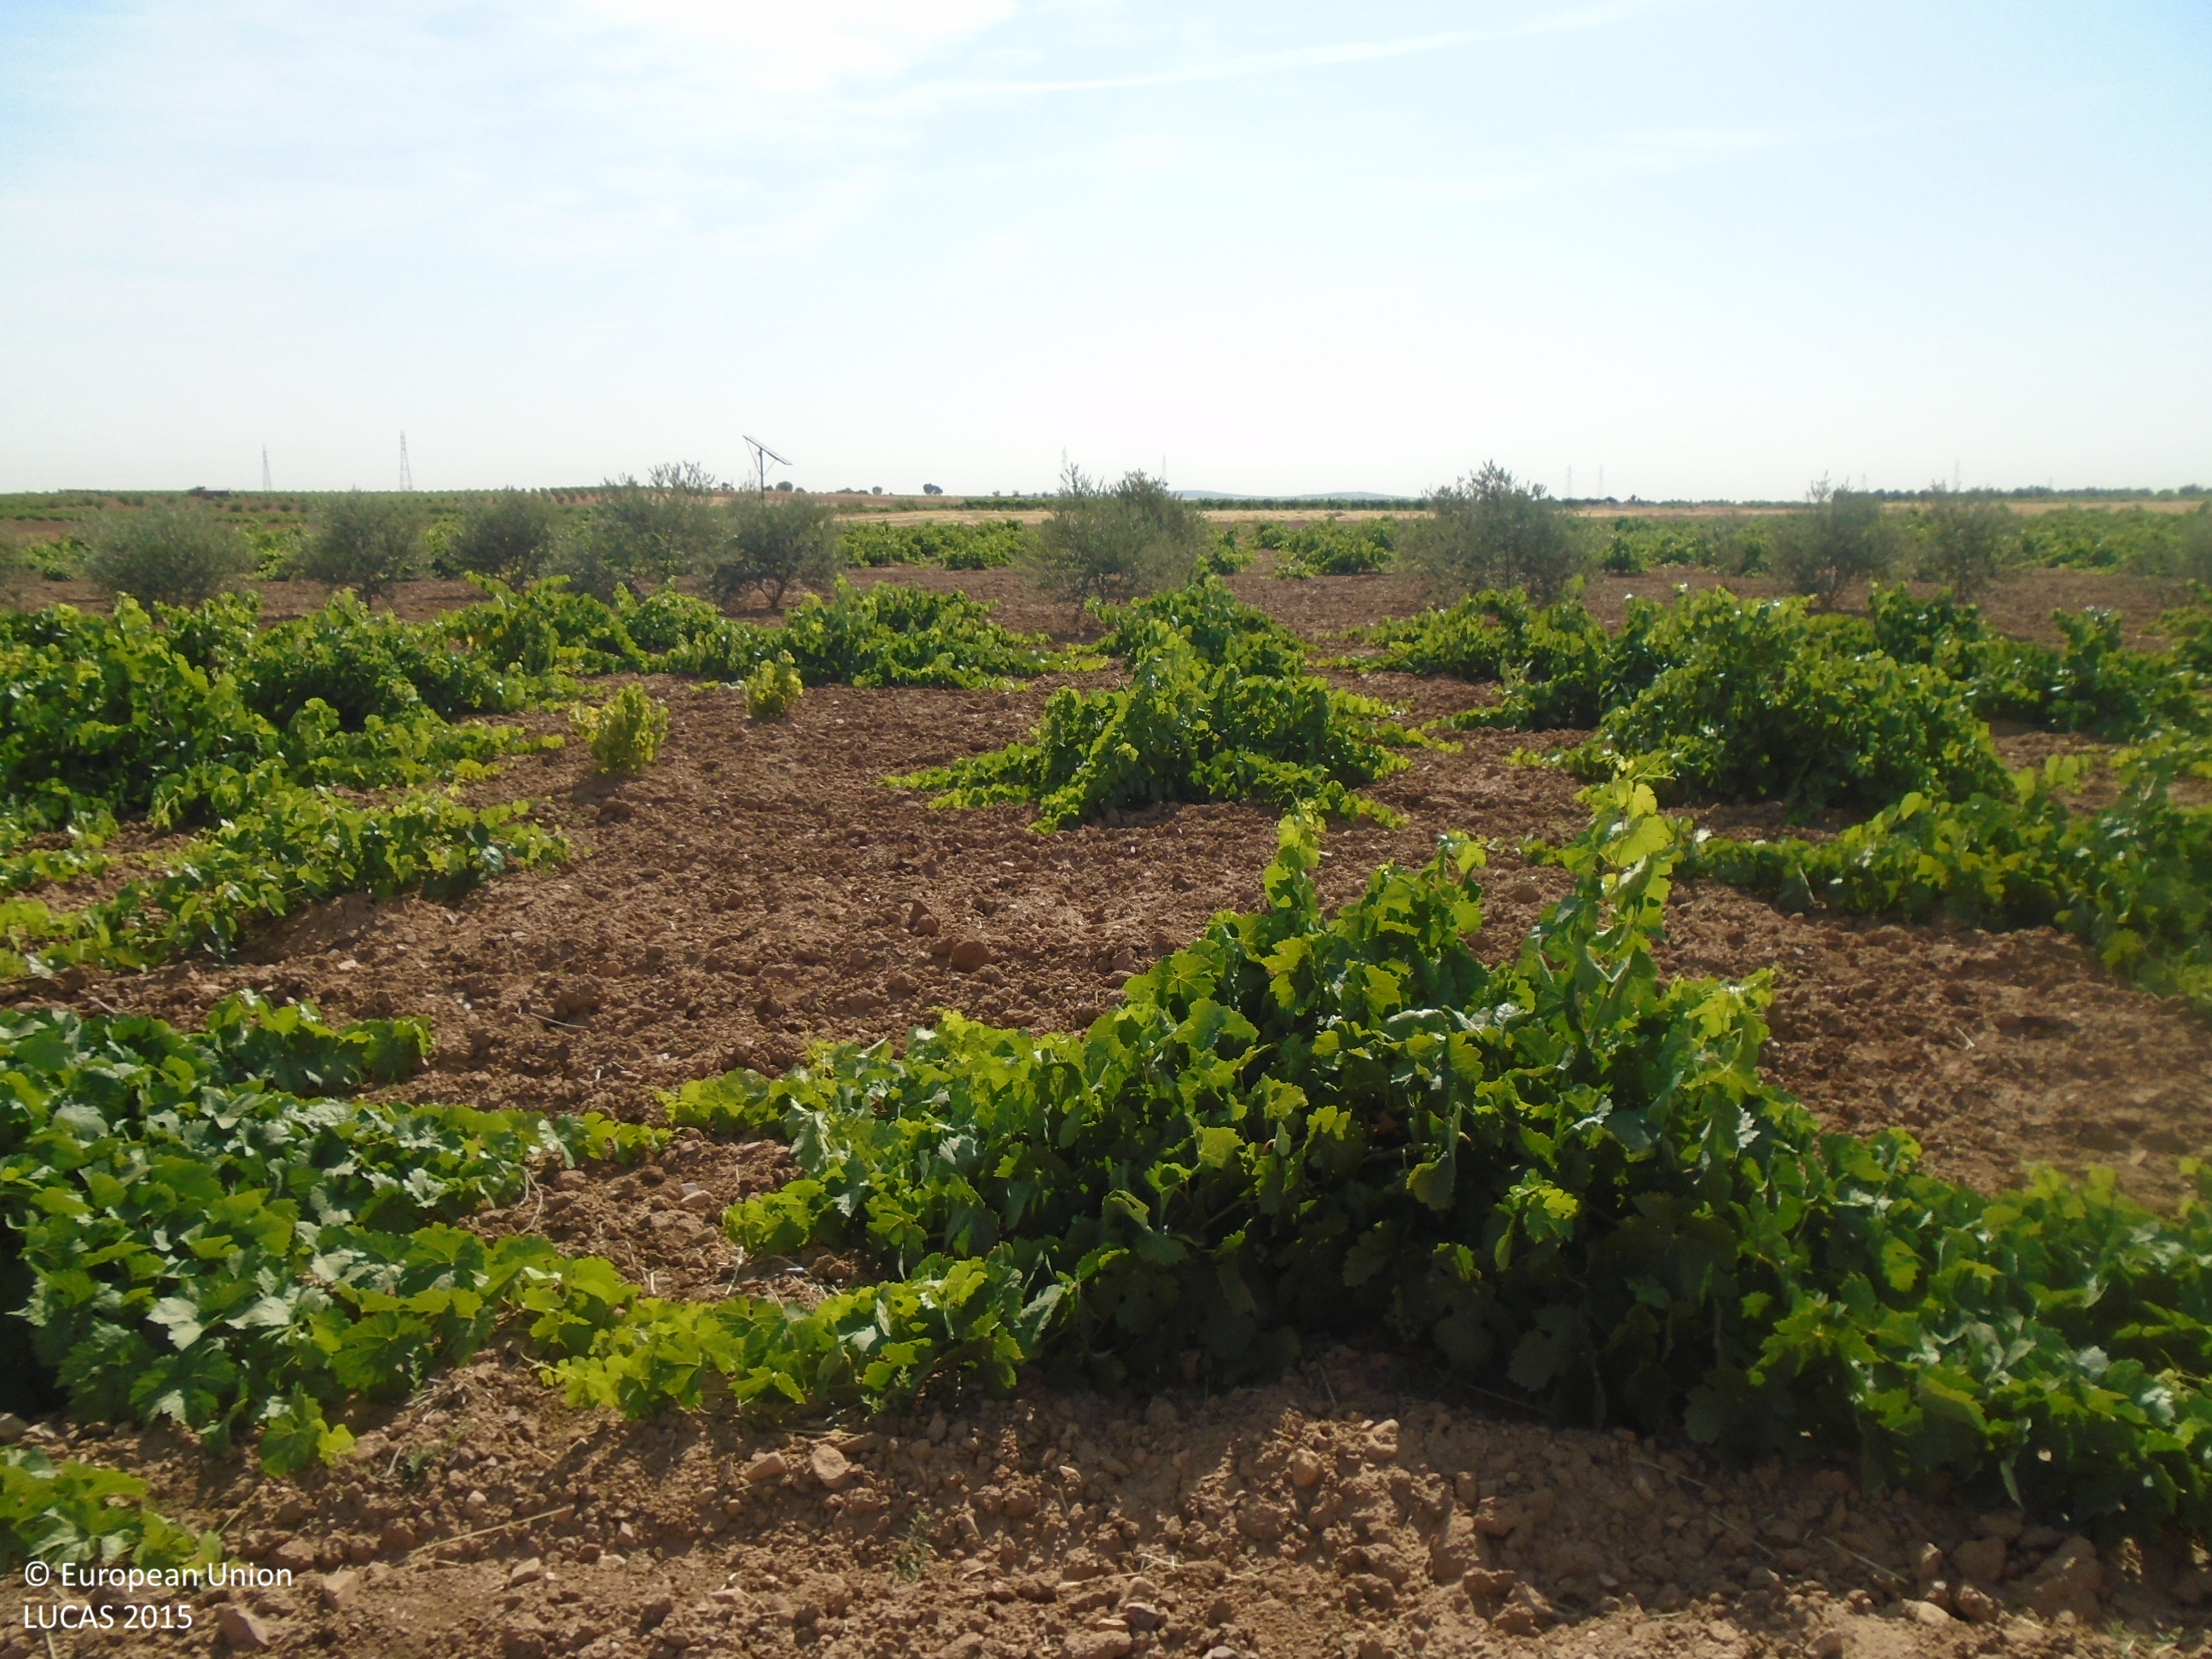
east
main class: Cropland
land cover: Vineyards
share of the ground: 10 - 25 %
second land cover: Other bare soil
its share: > 75 %
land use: Agriculture (excluding fallow land and kitchen gardens)
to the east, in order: Vineyards; Other bare soil; Olive groves; Vineyards; Grass margins; Other bare soil; Grass margins; Barley; Vineyards
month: July
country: ES
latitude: 39.4347
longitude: -3.5340
